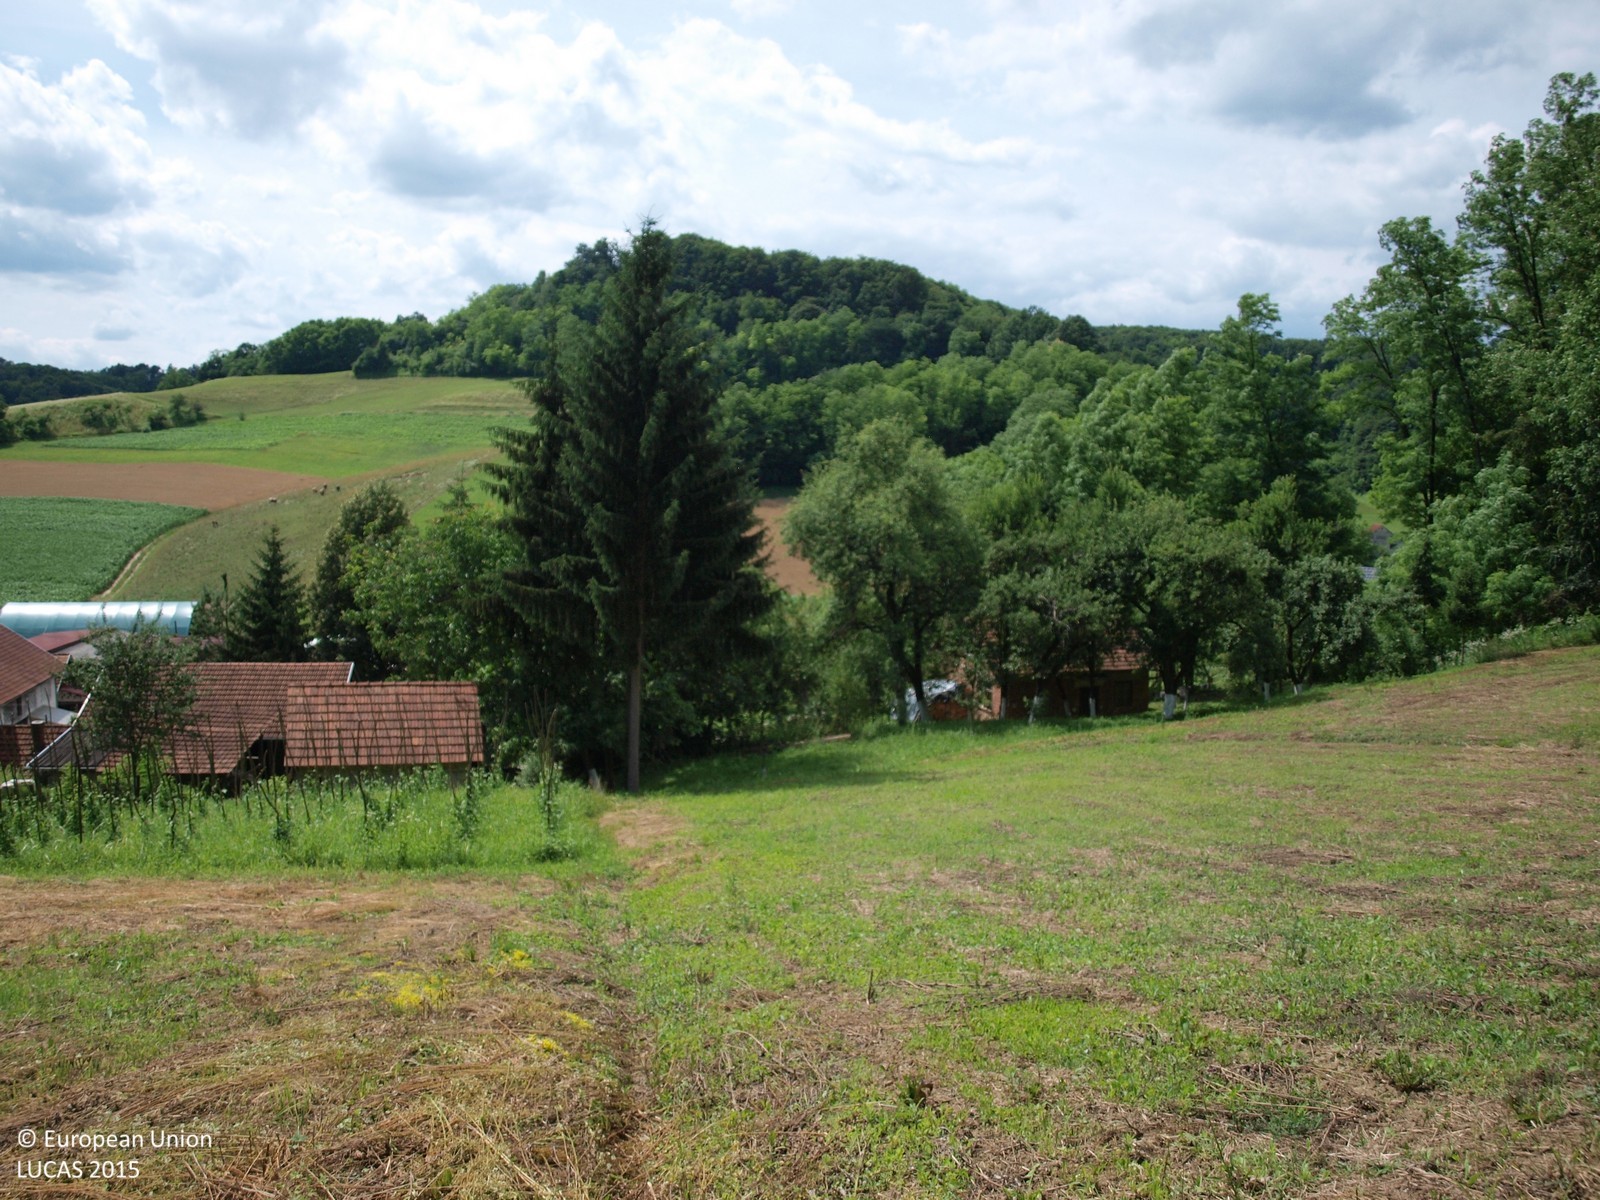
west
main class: Grassland
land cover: Grassland without tree/shrub cover
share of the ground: > 75 %
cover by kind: herbaceous plants 100 %
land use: Agriculture (excluding fallow land and kitchen gardens)
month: June
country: HR
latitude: 46.1446
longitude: 15.7075
